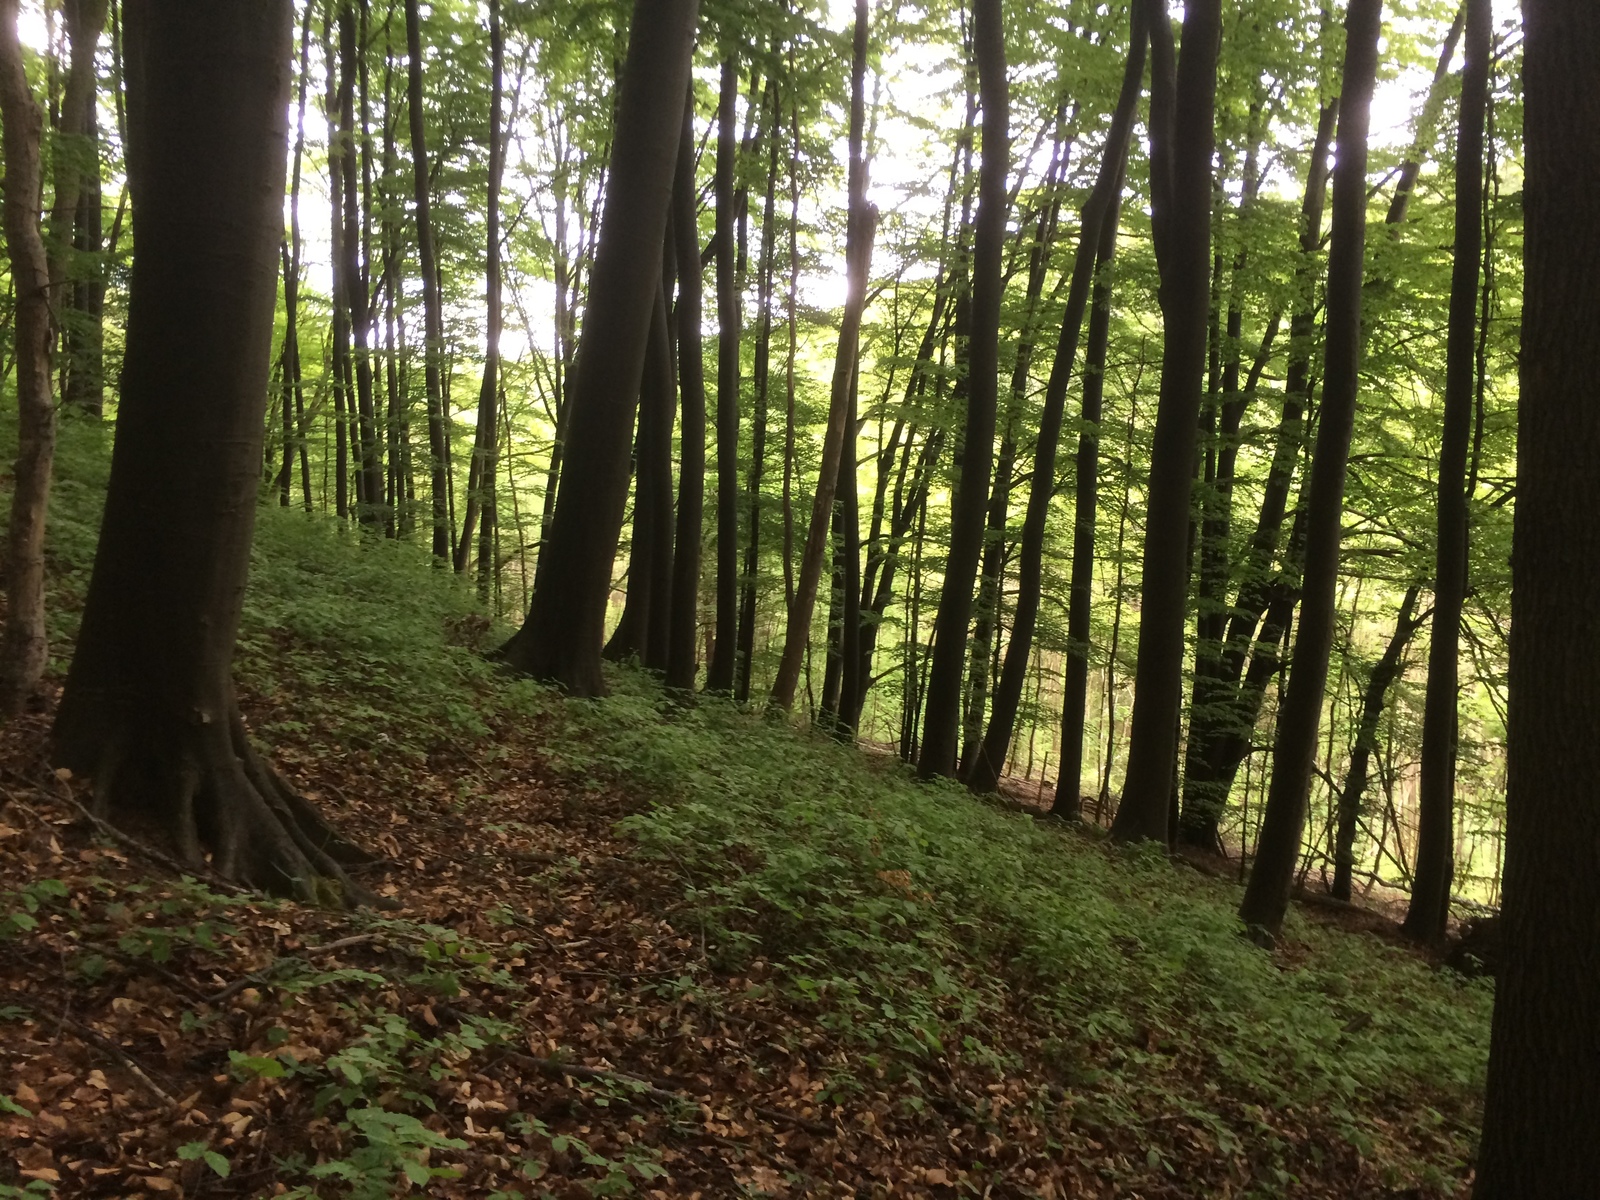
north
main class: Woodland
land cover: Broadleaved woodland
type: beech forest
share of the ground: > 75 %
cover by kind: broadleaved forest trees 100 %
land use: Forestry
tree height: > 5 m
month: May
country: AT
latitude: 48.1050
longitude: 16.1684
